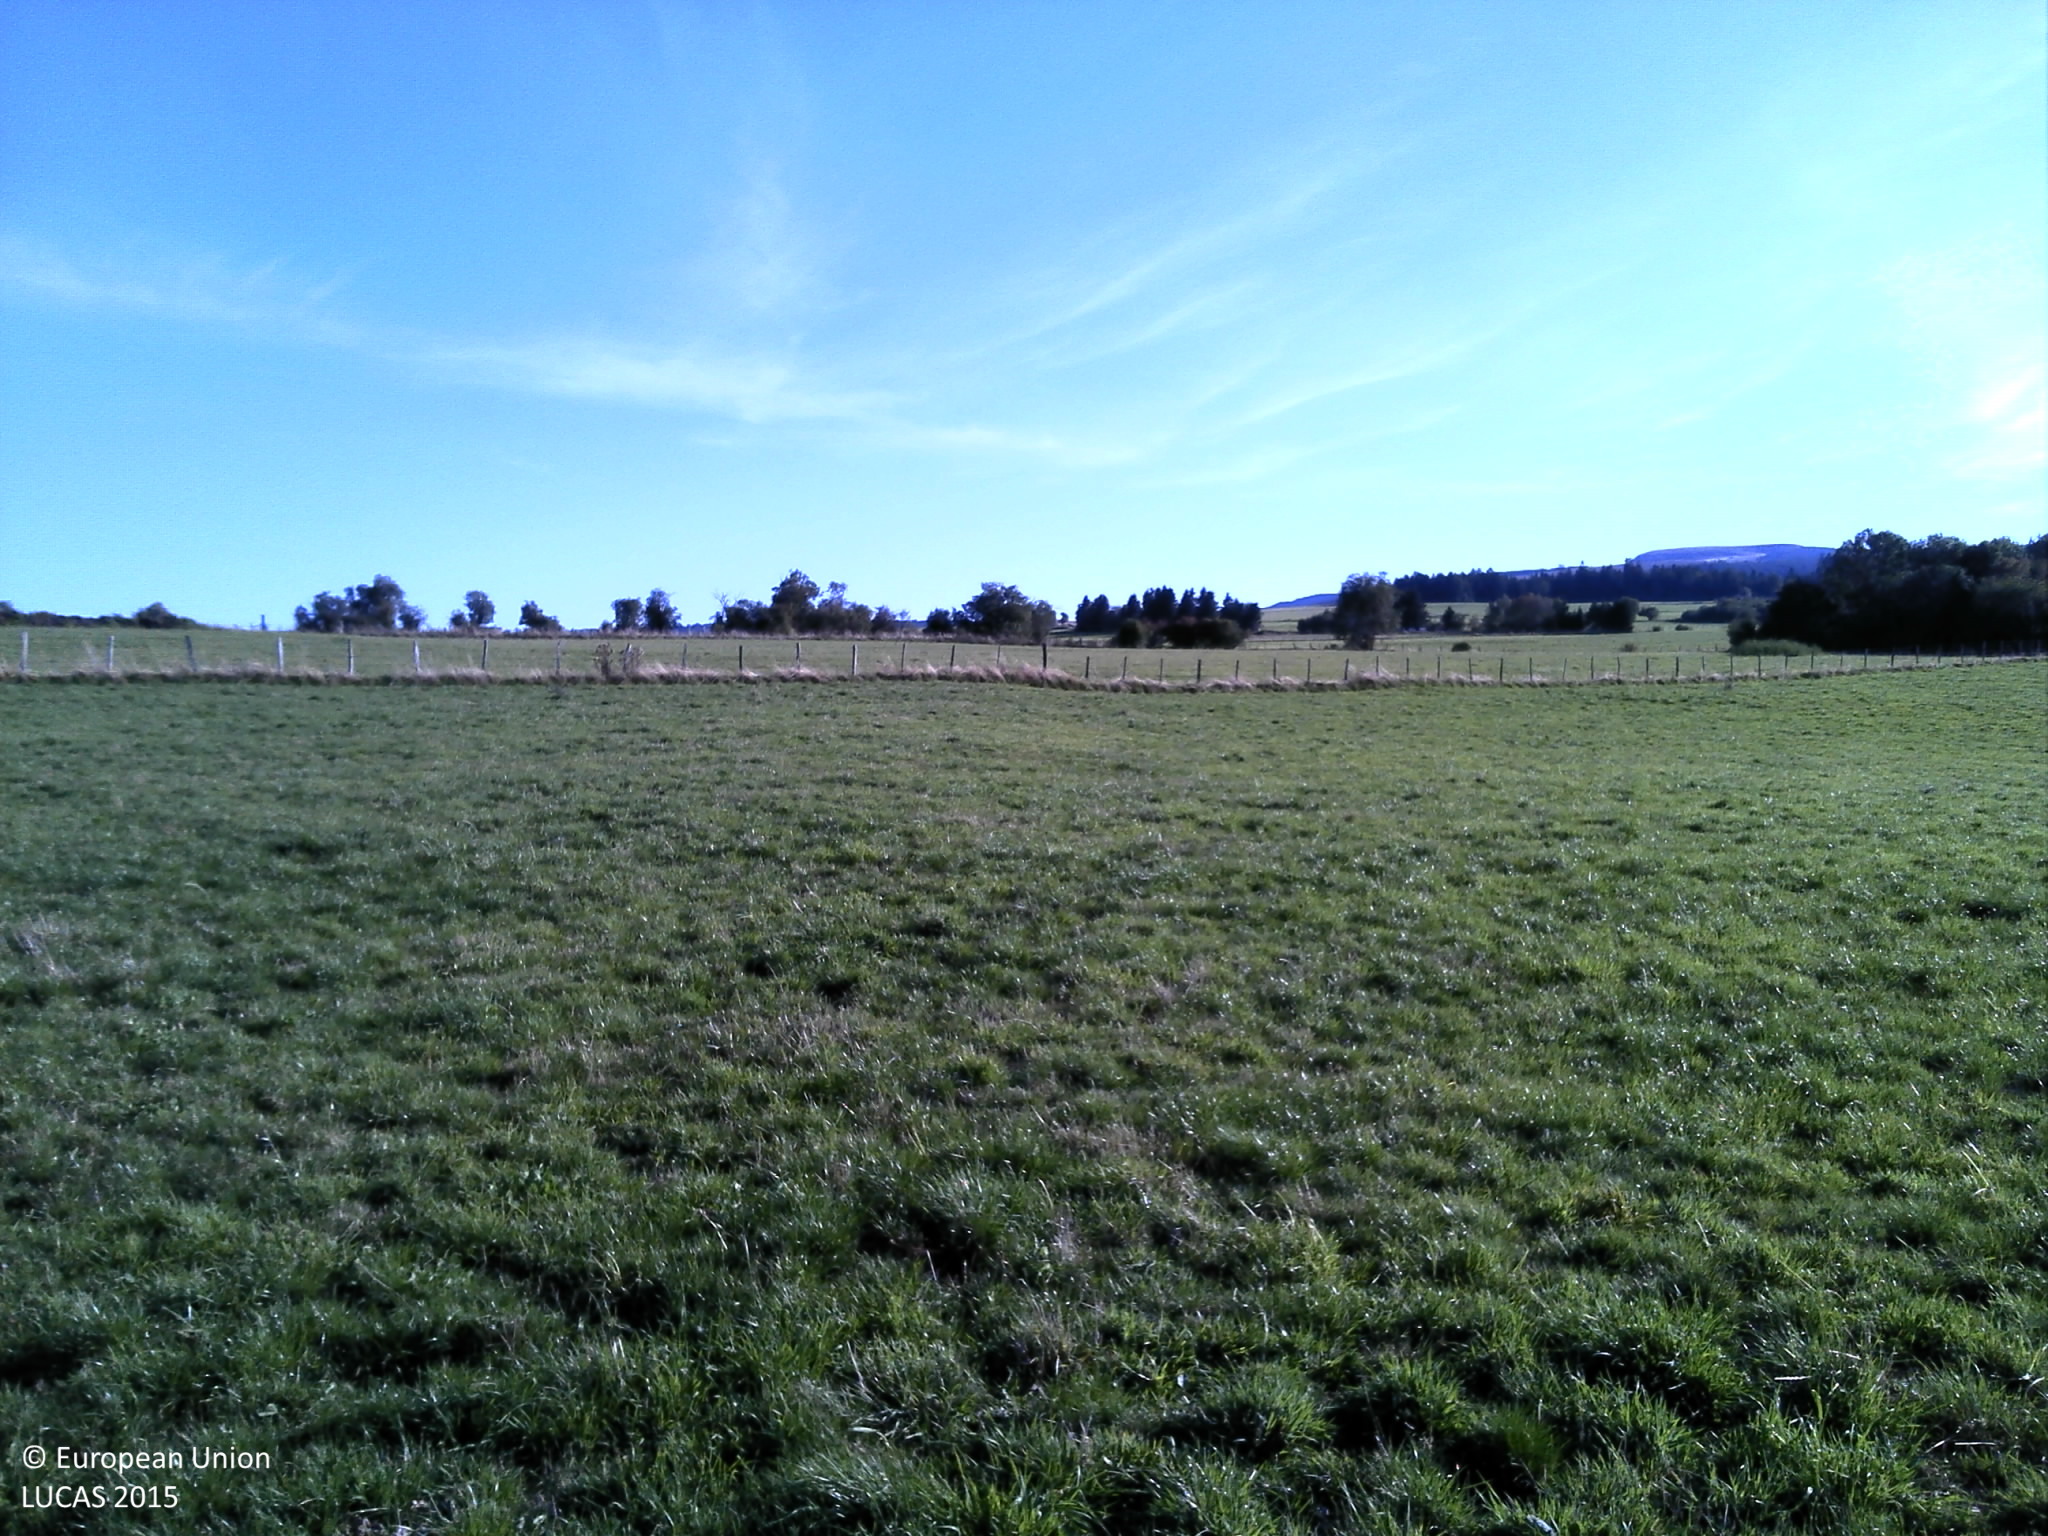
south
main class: Grassland
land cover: Grassland without tree/shrub cover
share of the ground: > 75 %
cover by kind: herbaceous plants 100 %
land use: Agriculture (excluding fallow land and kitchen gardens)
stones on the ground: < 10 %
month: September
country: FR
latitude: 45.6632
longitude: 2.9018
